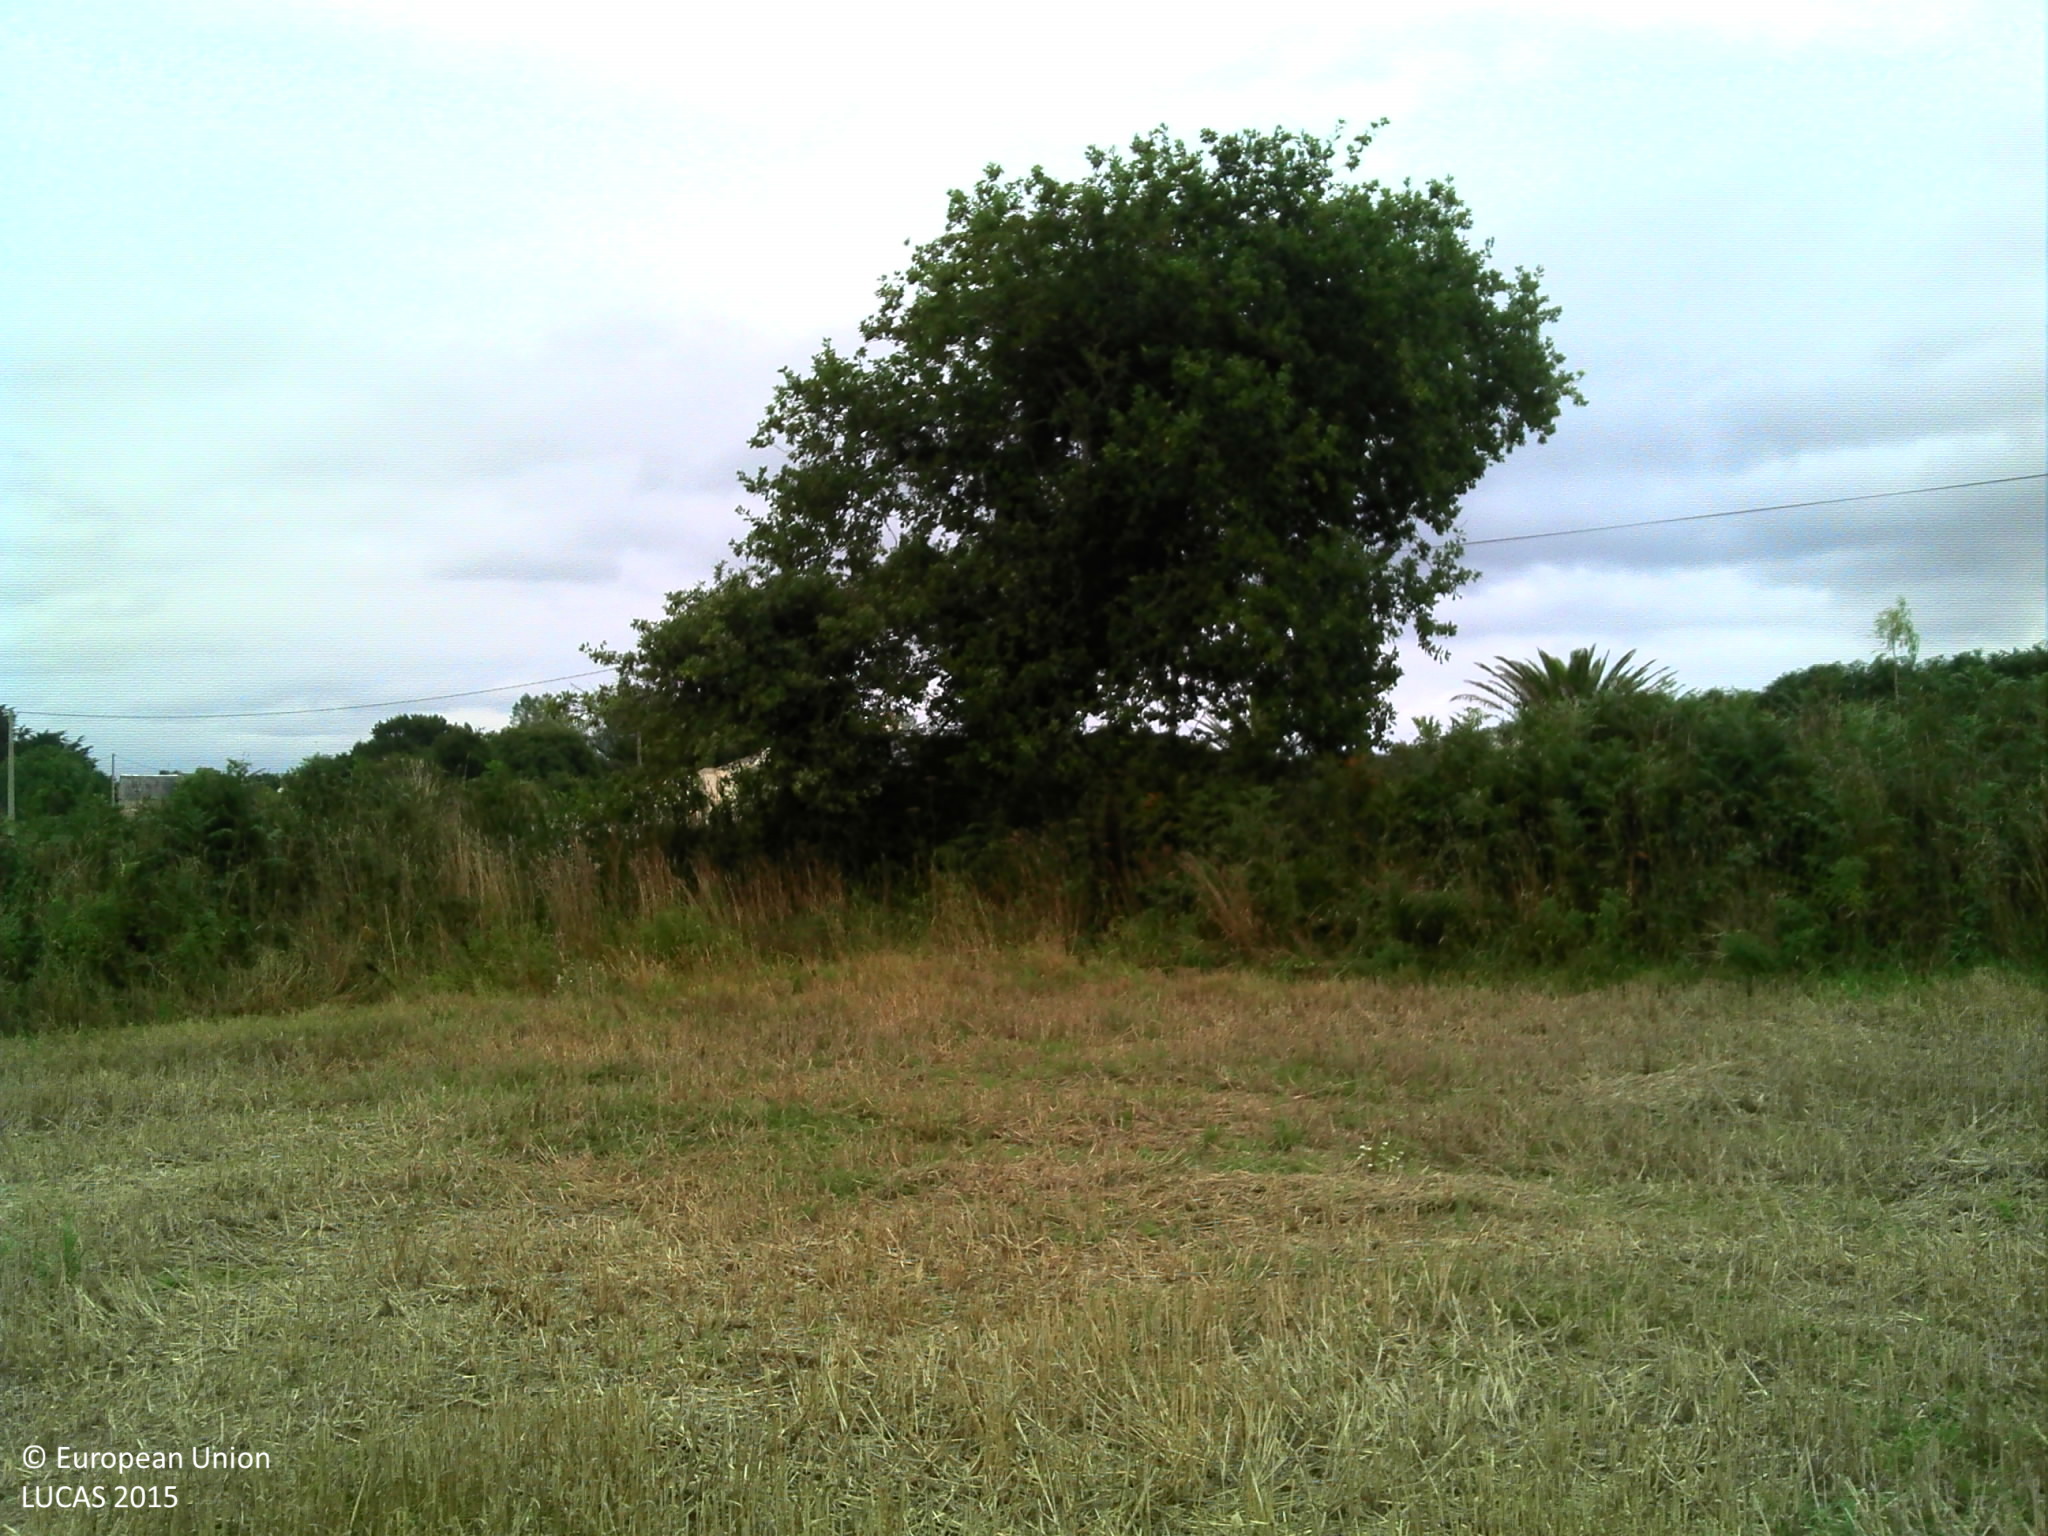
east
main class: Cropland
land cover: Common wheat
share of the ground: 50 - 75 %
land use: Agriculture (excluding fallow land and kitchen gardens)
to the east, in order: Common wheat; Abandoned hedges; Ditches and canals; Grass margins; Paved roads, cycling and walking lanes; Grass margins; Electric lines; Ditches and canals; Abandoned hedges; Grassland without tree/shrub cover; Managed hedges; Other fresh vegetables; Abandoned hedges; Other fresh vegetables; Abandoned hedges; Tracks; Abandoned hedges; Common wheat
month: August
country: FR
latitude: 48.8060
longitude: -3.2419
